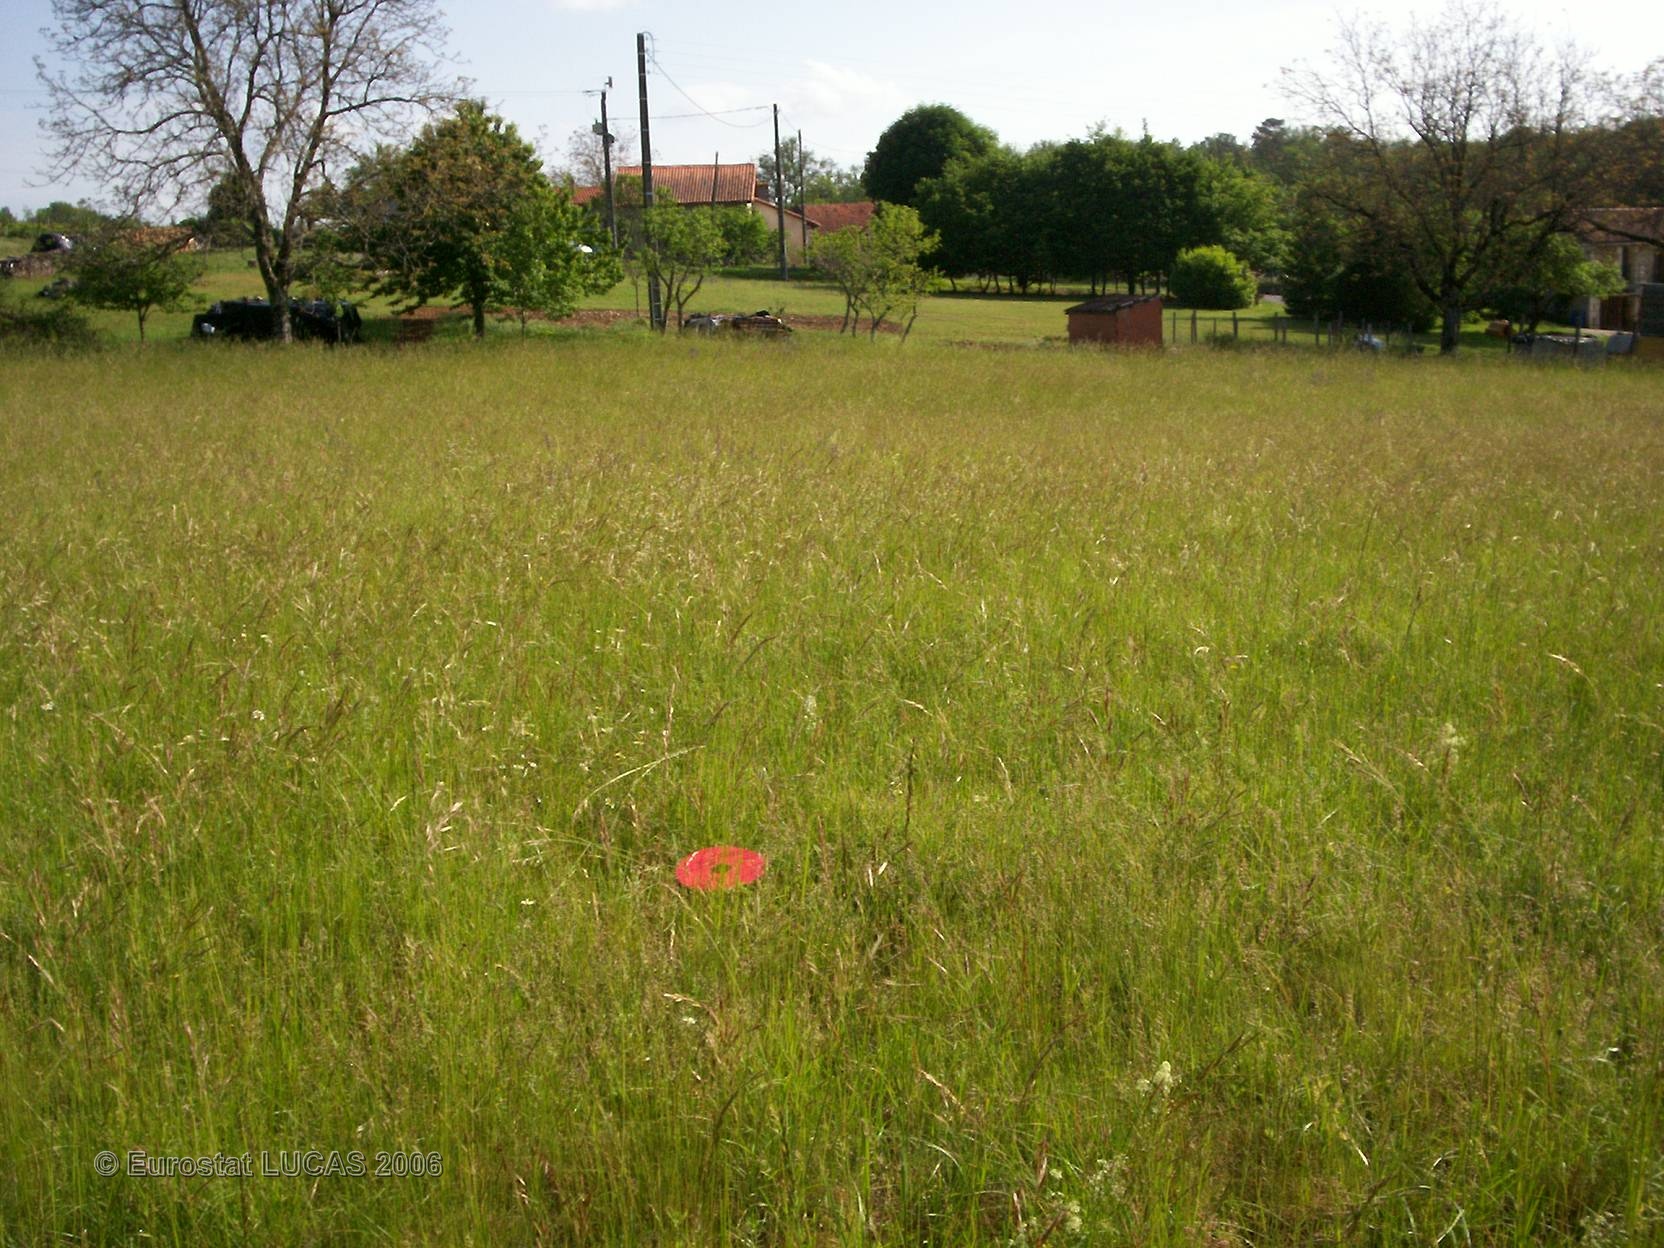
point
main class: Grassland
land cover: Grassland without tree/shrub cover
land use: Agriculture (excluding fallow land and kitchen gardens)
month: May
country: FR
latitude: 45.3590
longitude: 0.6313
